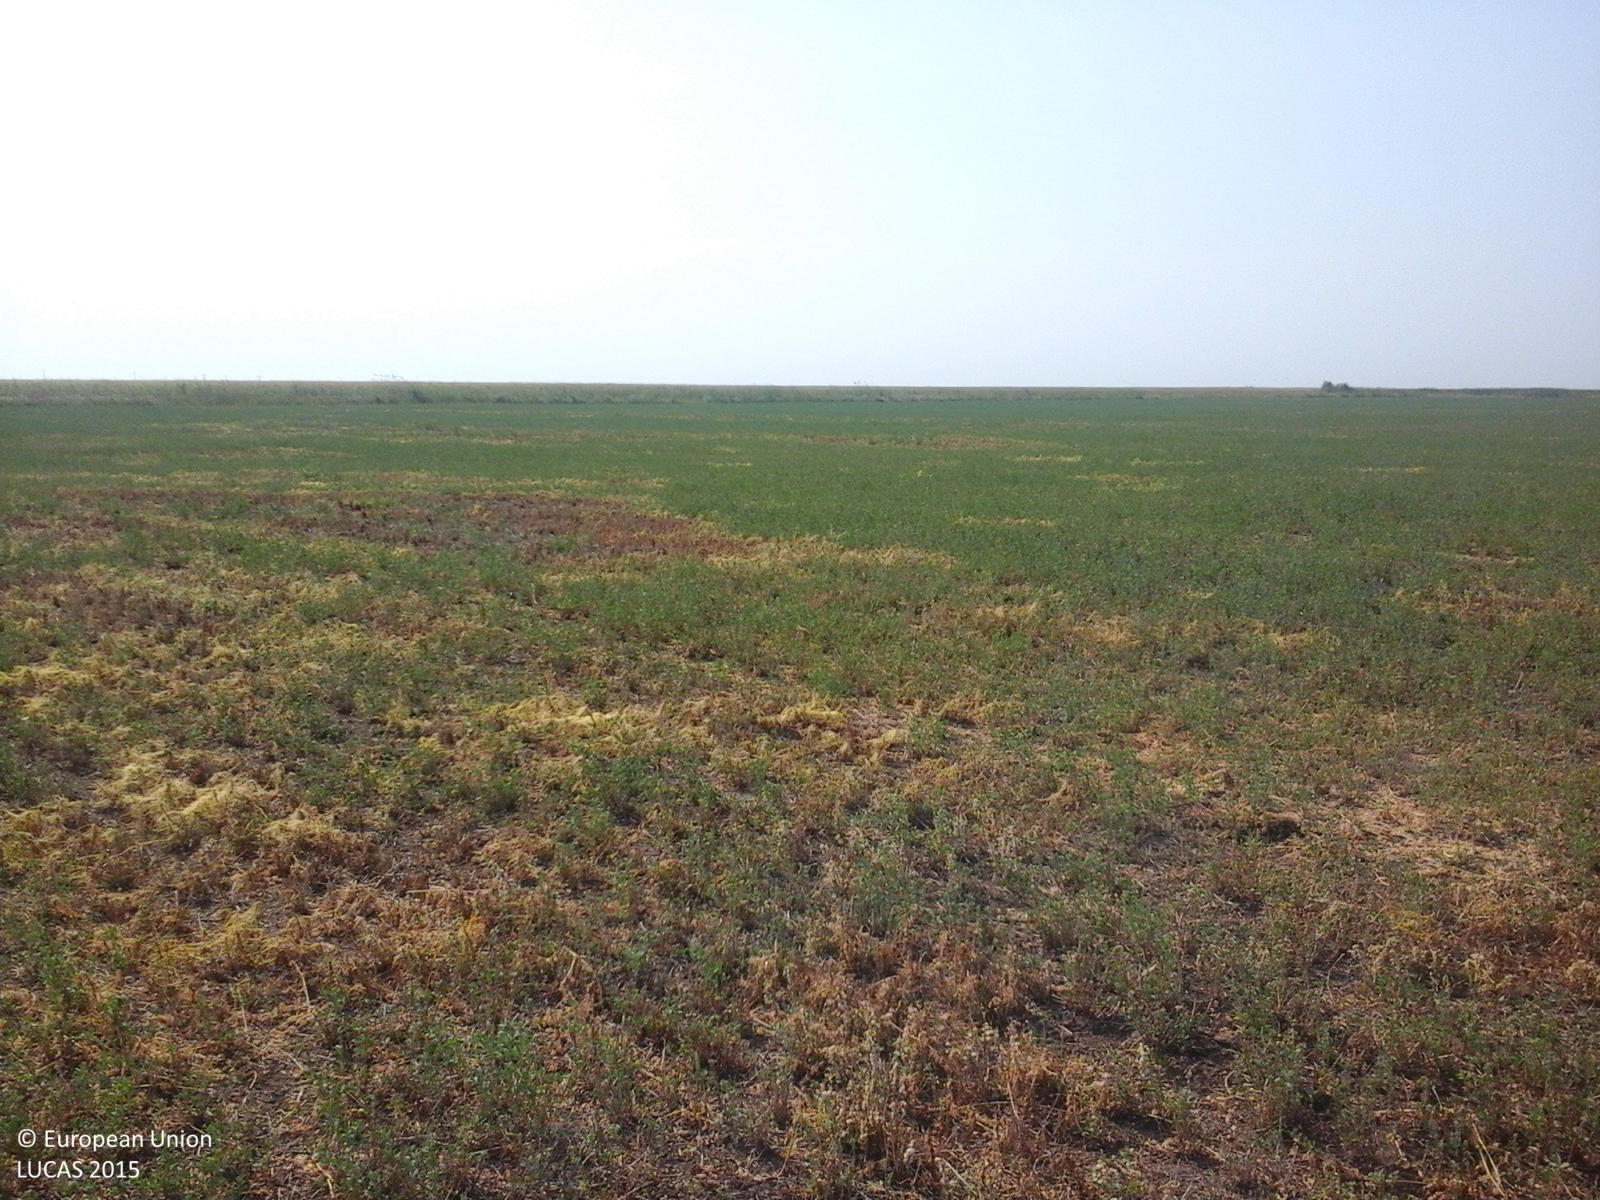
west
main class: Cropland
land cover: Lucerne
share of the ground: > 75 %
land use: Agriculture (excluding fallow land and kitchen gardens)
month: August
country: RO
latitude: 45.0226
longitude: 27.3924
